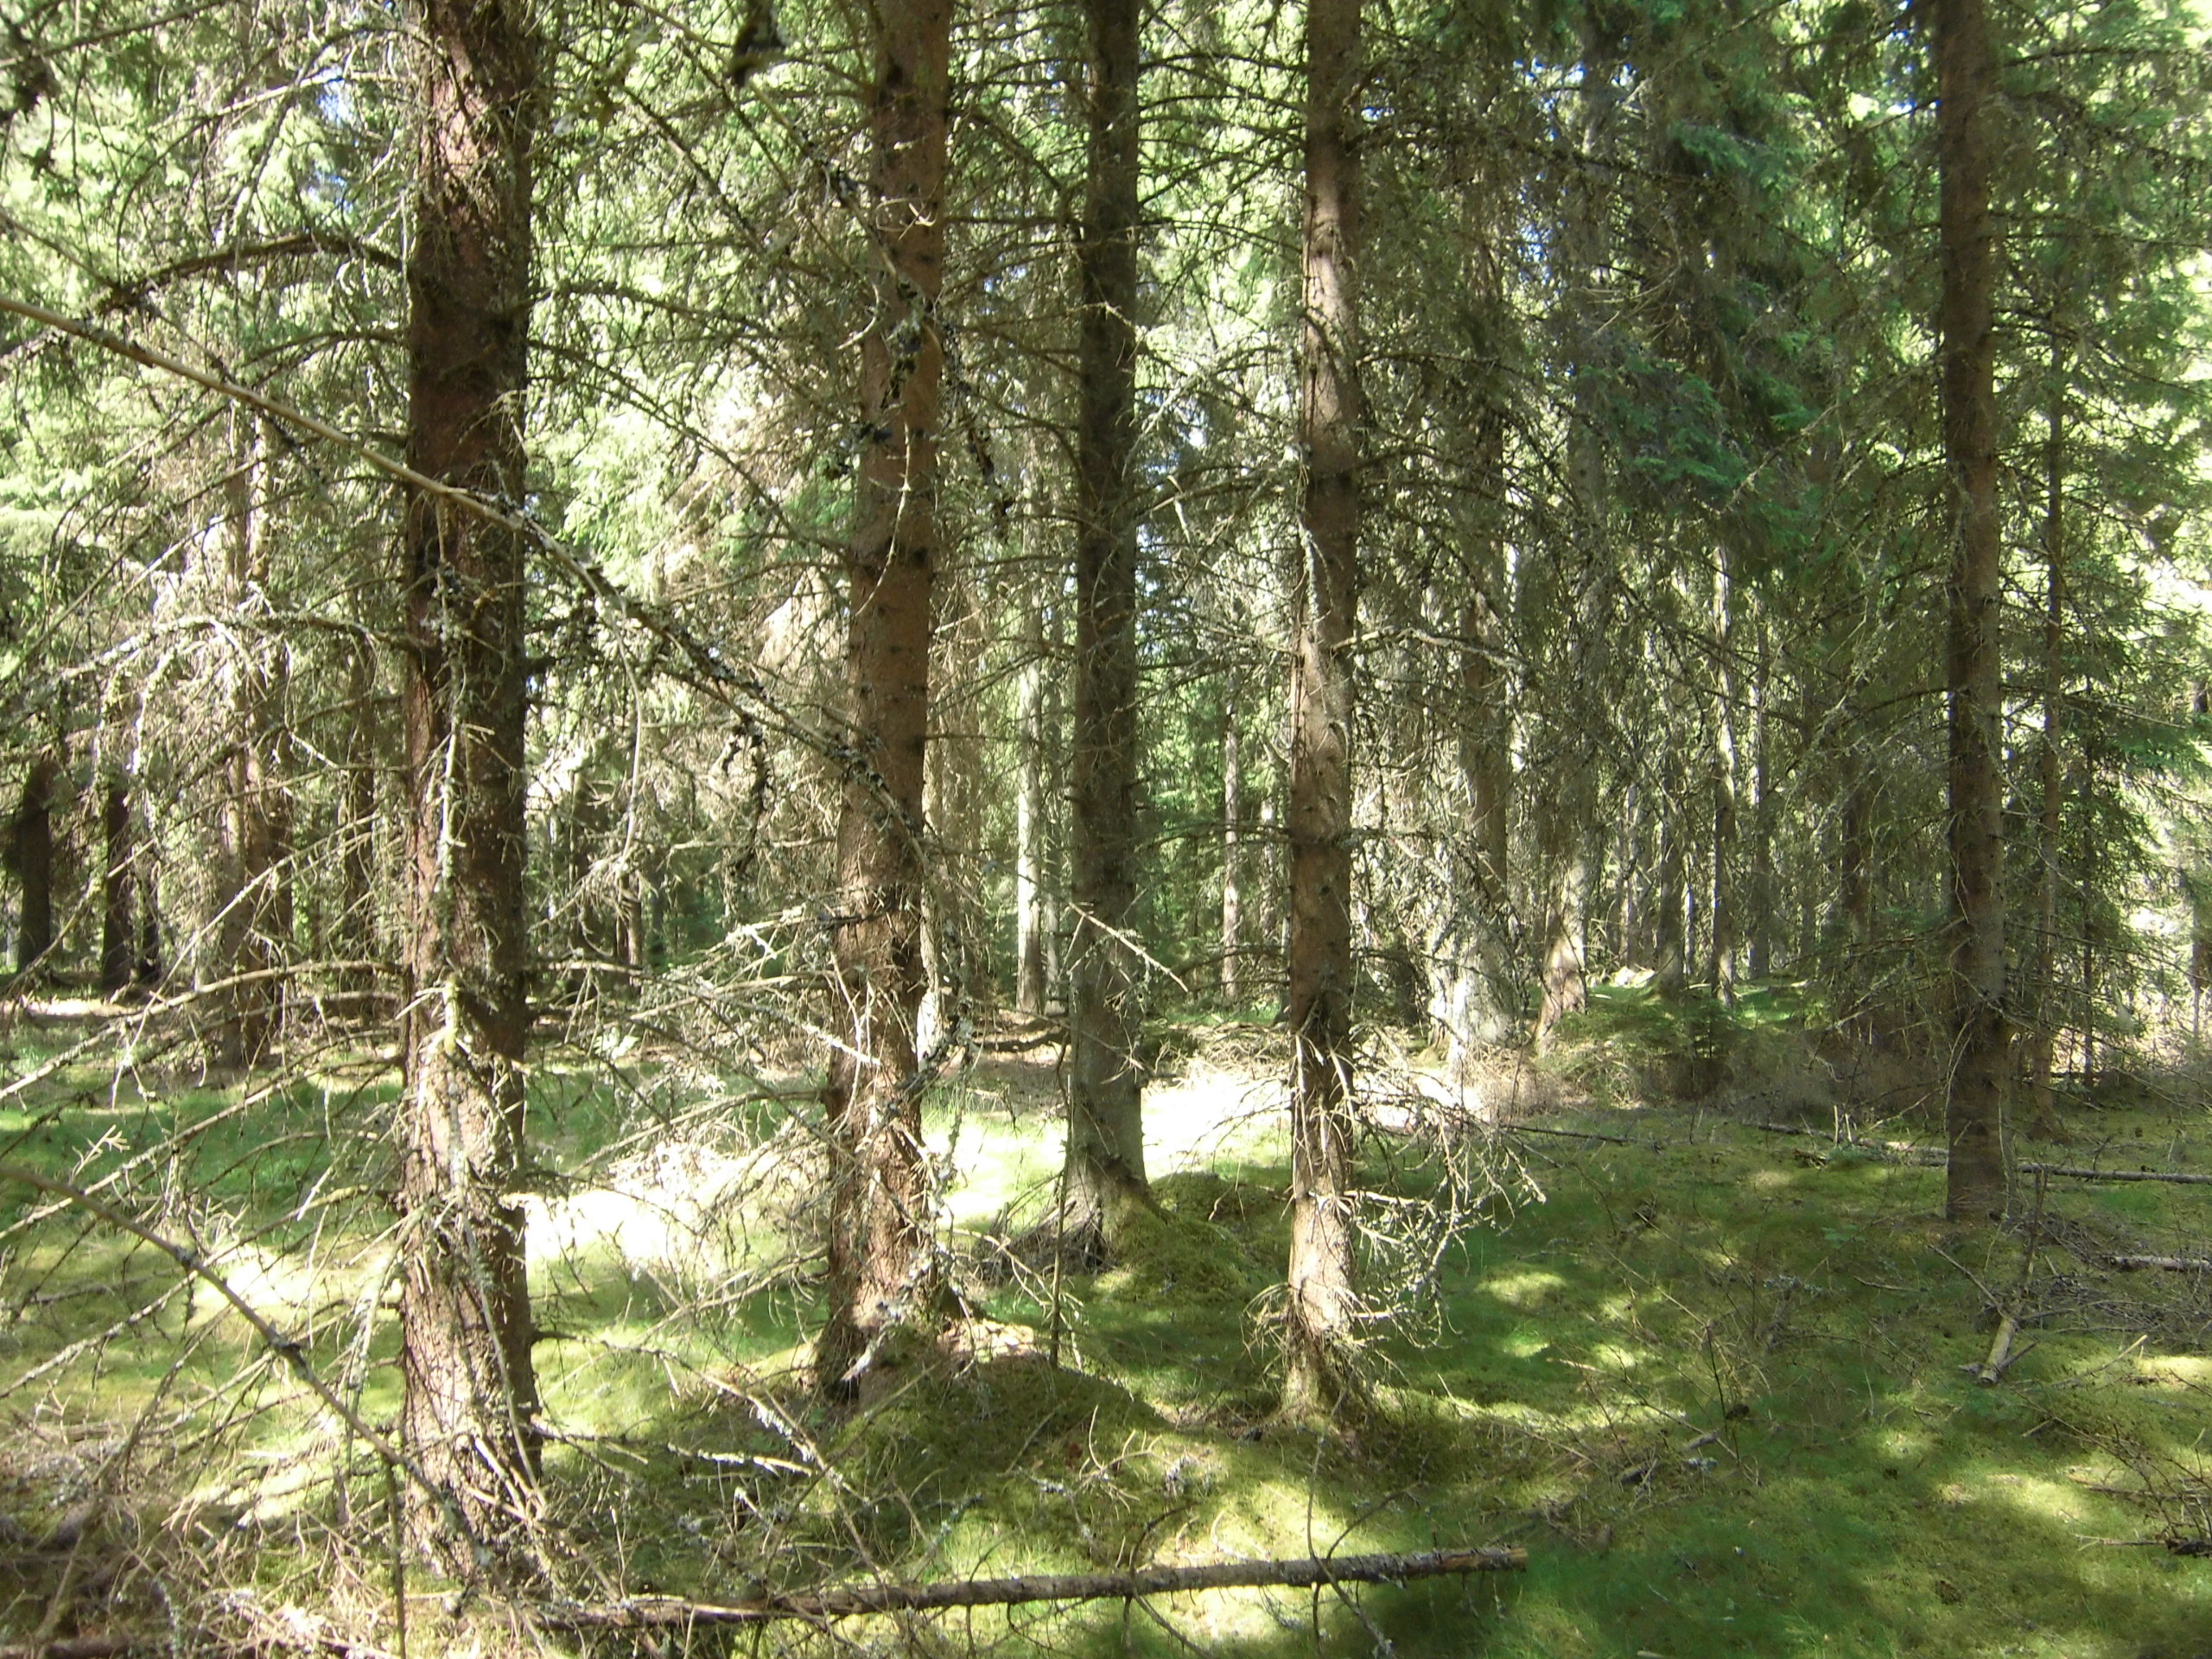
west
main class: Woodland
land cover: Spruce dominated coniferous woodland
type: boreal forest
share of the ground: 50 - 75 %
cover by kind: coniferous forest trees 70 %, lichens and mosses 20 %, shrubs 5 %, unconsolidated bare surface 5 %
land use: Forestry
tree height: > 5 m
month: July
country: SE
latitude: 57.2550
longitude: 14.6874
